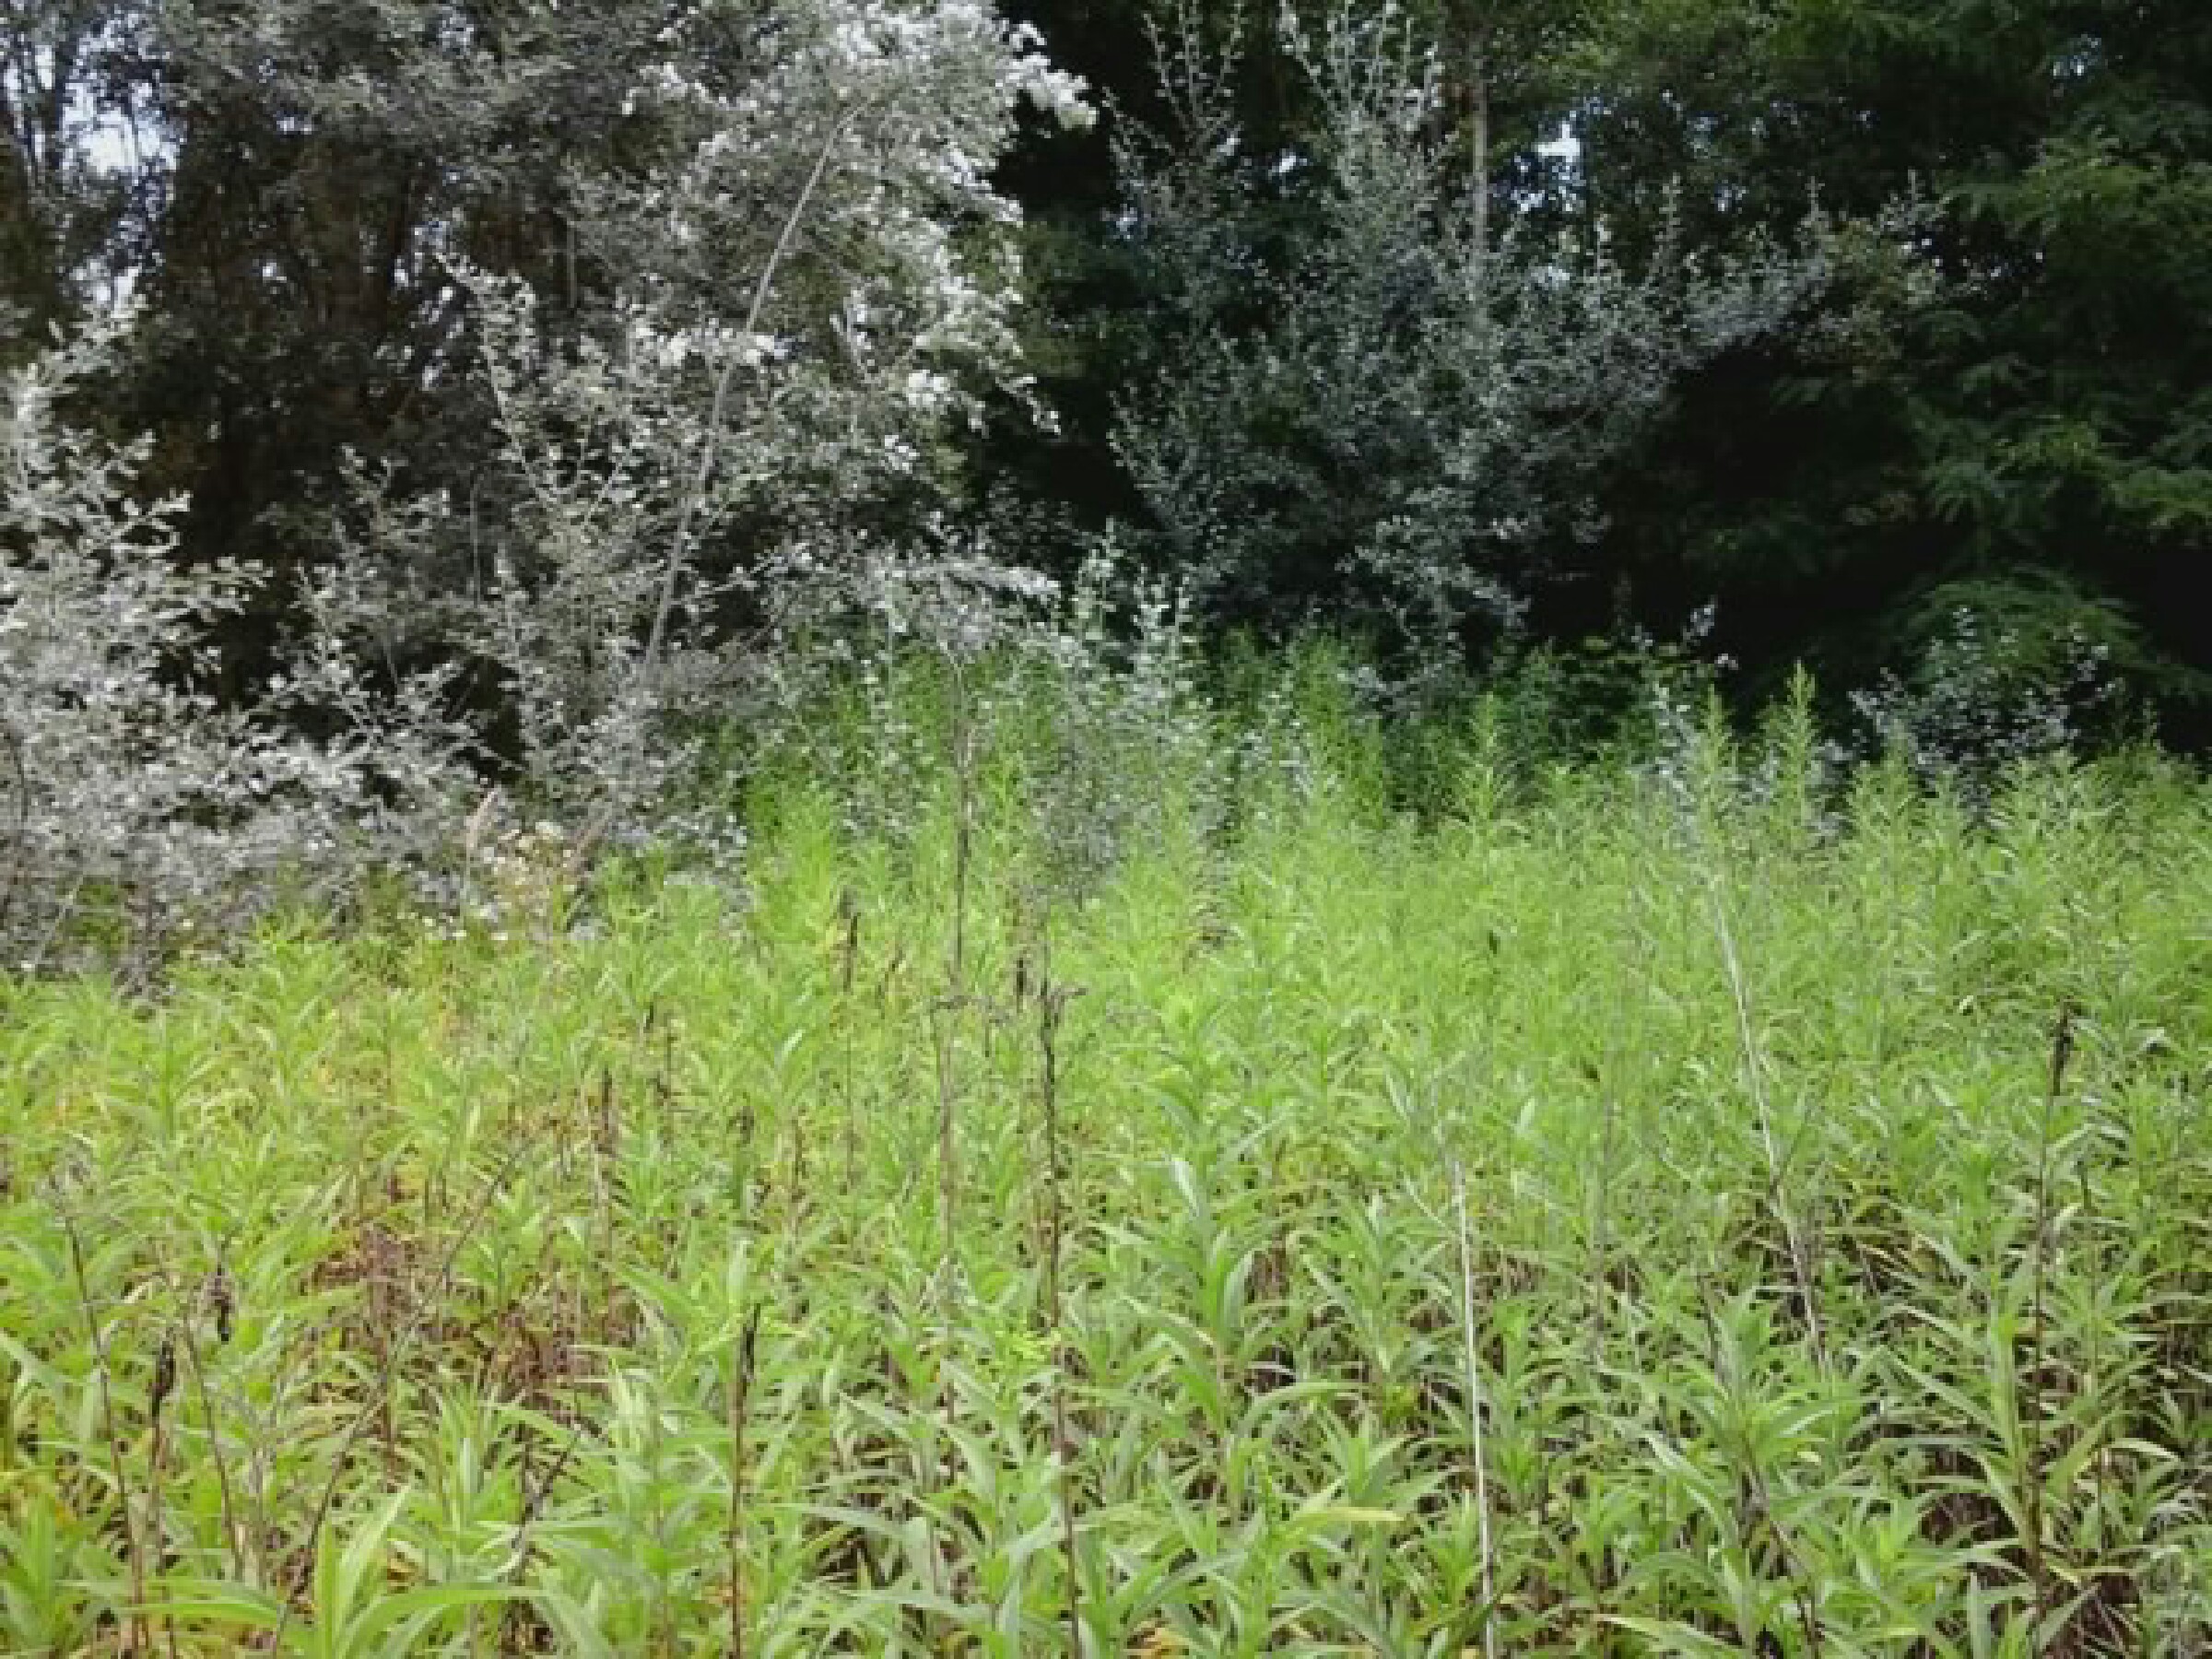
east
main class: Grassland
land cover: Spontaneously vegetated surfaces
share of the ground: > 75 %
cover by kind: herbaceous plants 100 %
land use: Semi-natural and natural areas not in use
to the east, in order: Spontaneously vegetated surfaces; Broadleaved woodland; Spontaneously vegetated surfaces; Shrubland without tree cover; Spontaneously vegetated surfaces; Ditches and canals; Railways; Electric lines; Railways; Electric lines; Ditches and canals; Spontaneously vegetated surfaces; Shrubland without tree cover; Spontaneously vegetated surfaces; Tracks; Grassland without tree/shrub cover; Shruby margins; Tracks; Grass margins; Artificial constructions in urban areas
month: July
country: HU
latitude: 47.7512
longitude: 19.1566
